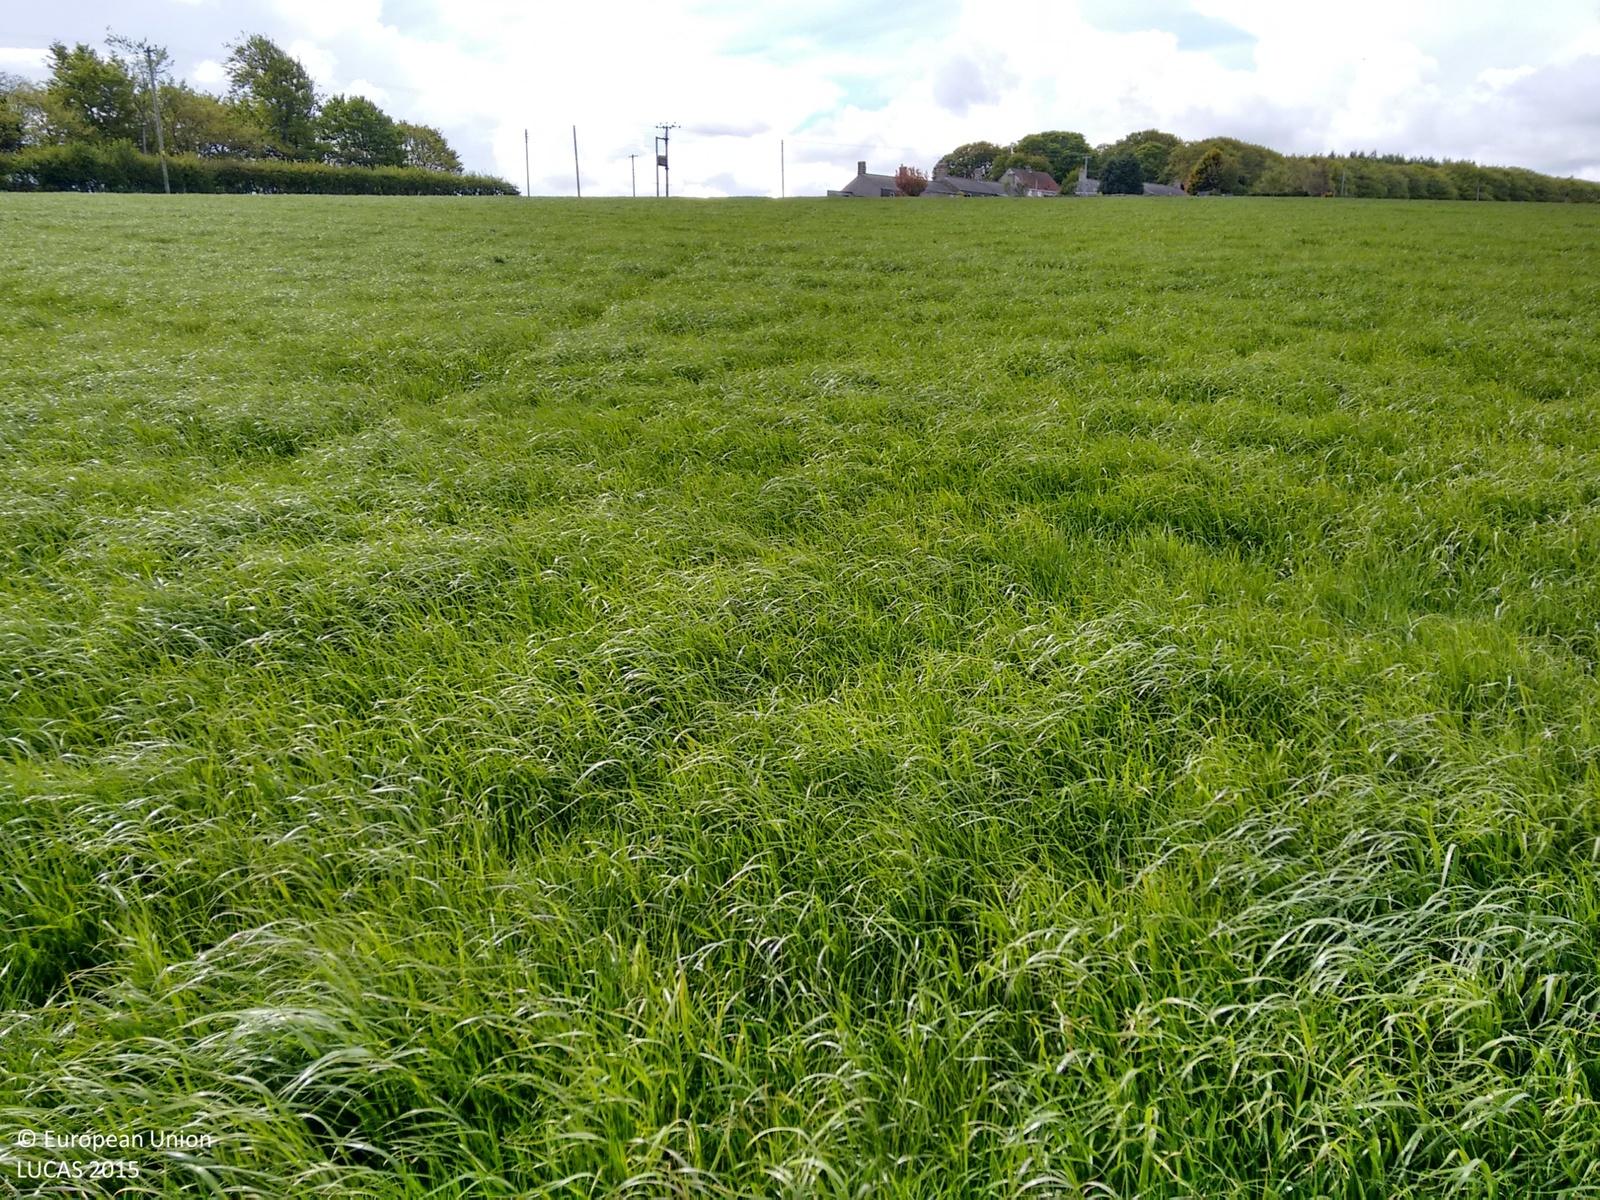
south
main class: Grassland
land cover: Grassland without tree/shrub cover
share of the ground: > 75 %
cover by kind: herbaceous plants 100 %
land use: Agriculture (excluding fallow land and kitchen gardens)
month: May
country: GB
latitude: 55.8621
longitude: -2.3441
